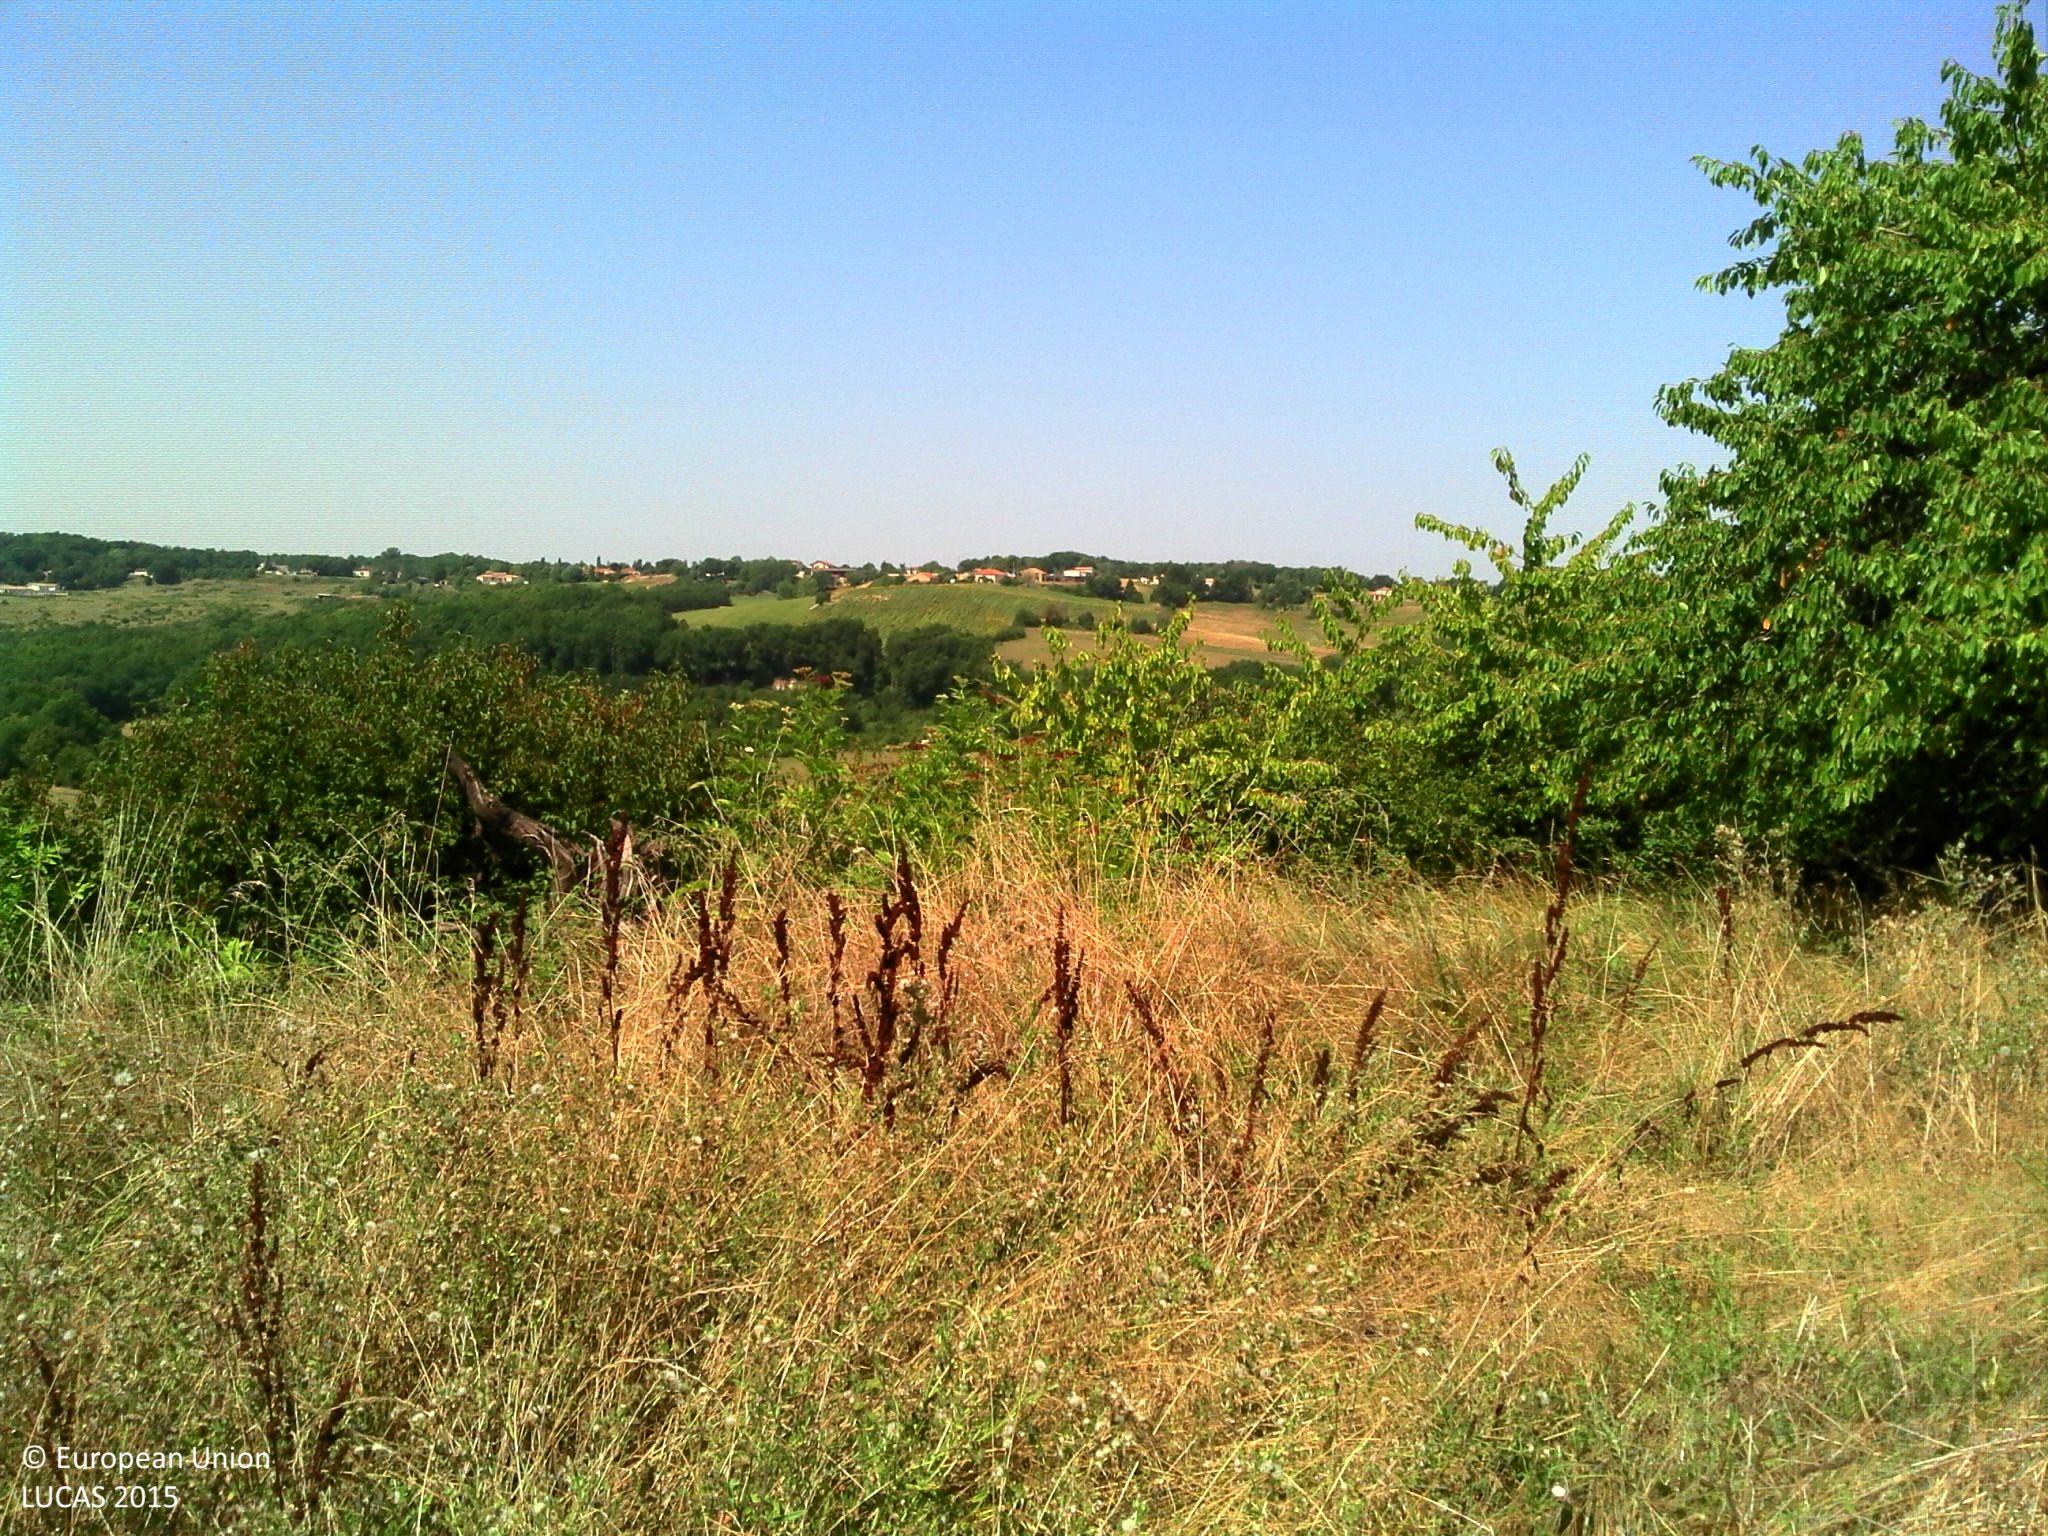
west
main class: Grassland
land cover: Spontaneously vegetated surfaces
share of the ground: > 75 %
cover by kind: herbaceous plants 100 %
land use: Fallow land
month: August
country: FR
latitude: 44.1414
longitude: 0.6070
